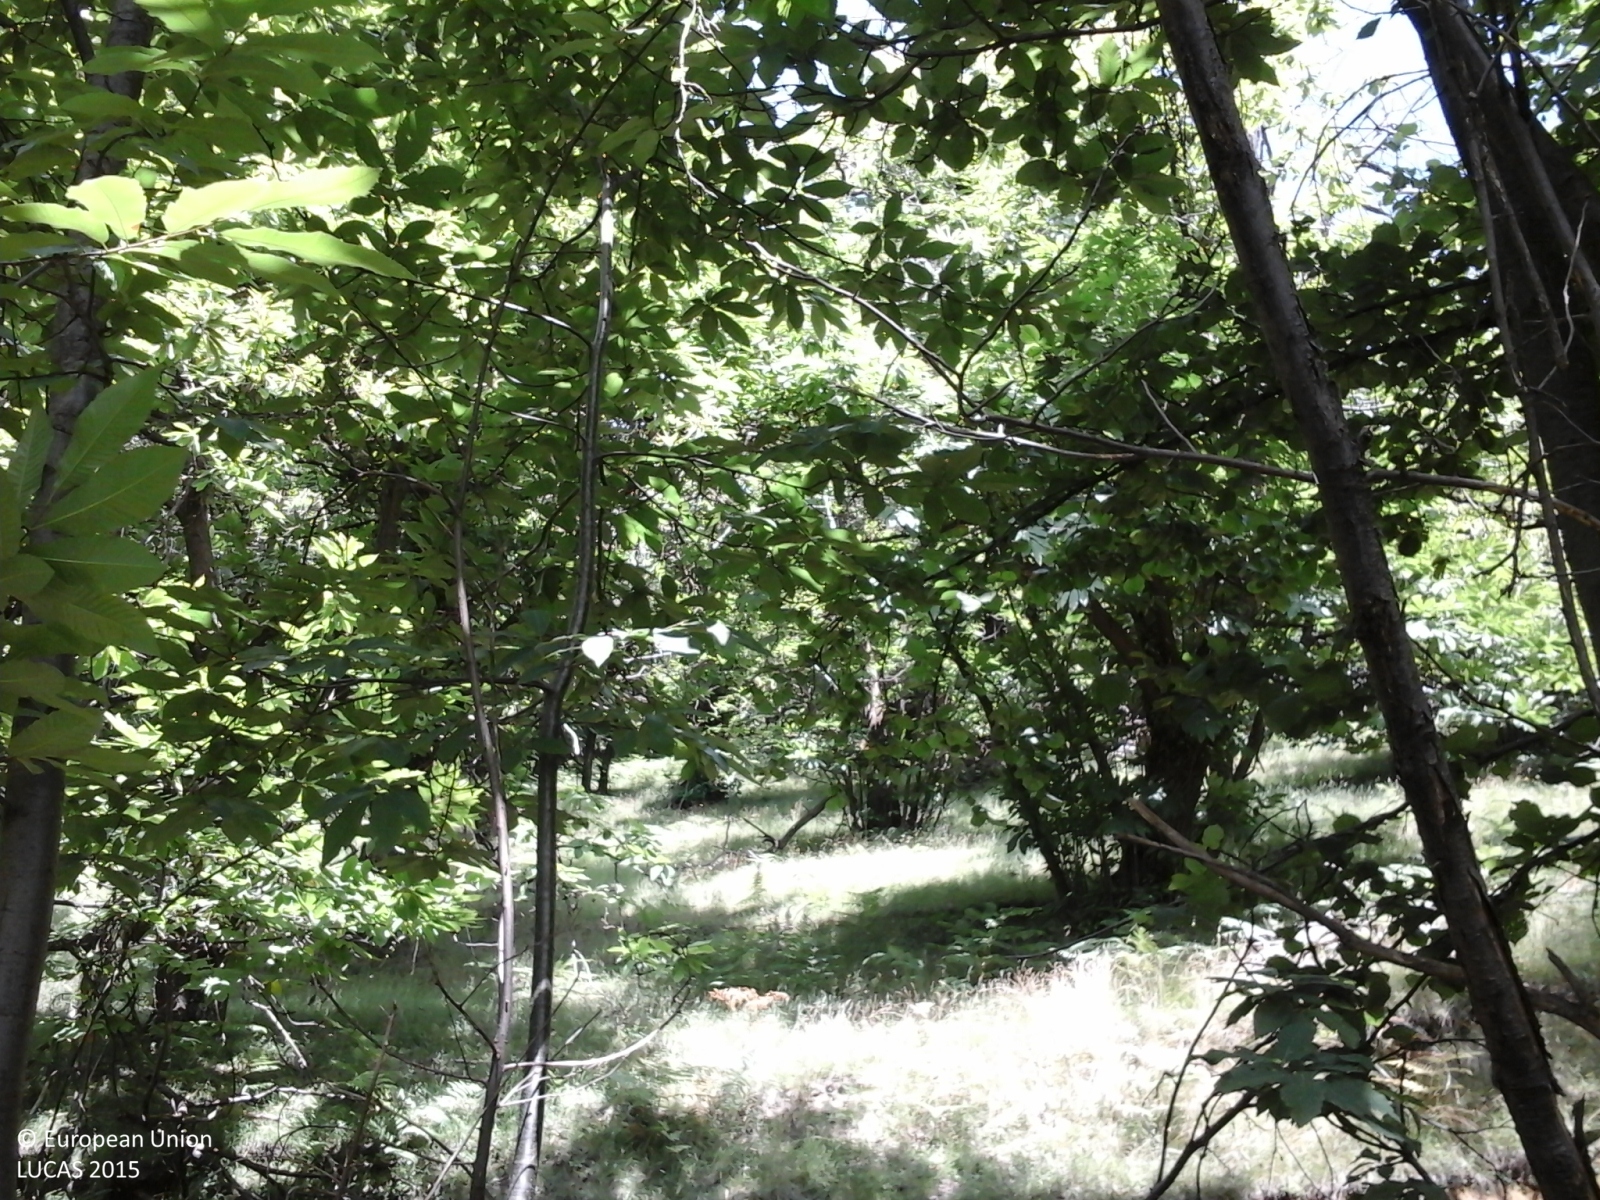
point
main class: Woodland
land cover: Broadleaved woodland
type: thermophilous deciduous forest
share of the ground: > 75 %
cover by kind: broadleaved forest trees 100 %
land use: Semi-natural and natural areas not in use
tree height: > 5 m
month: June
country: IT
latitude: 44.3084
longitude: 7.7609
